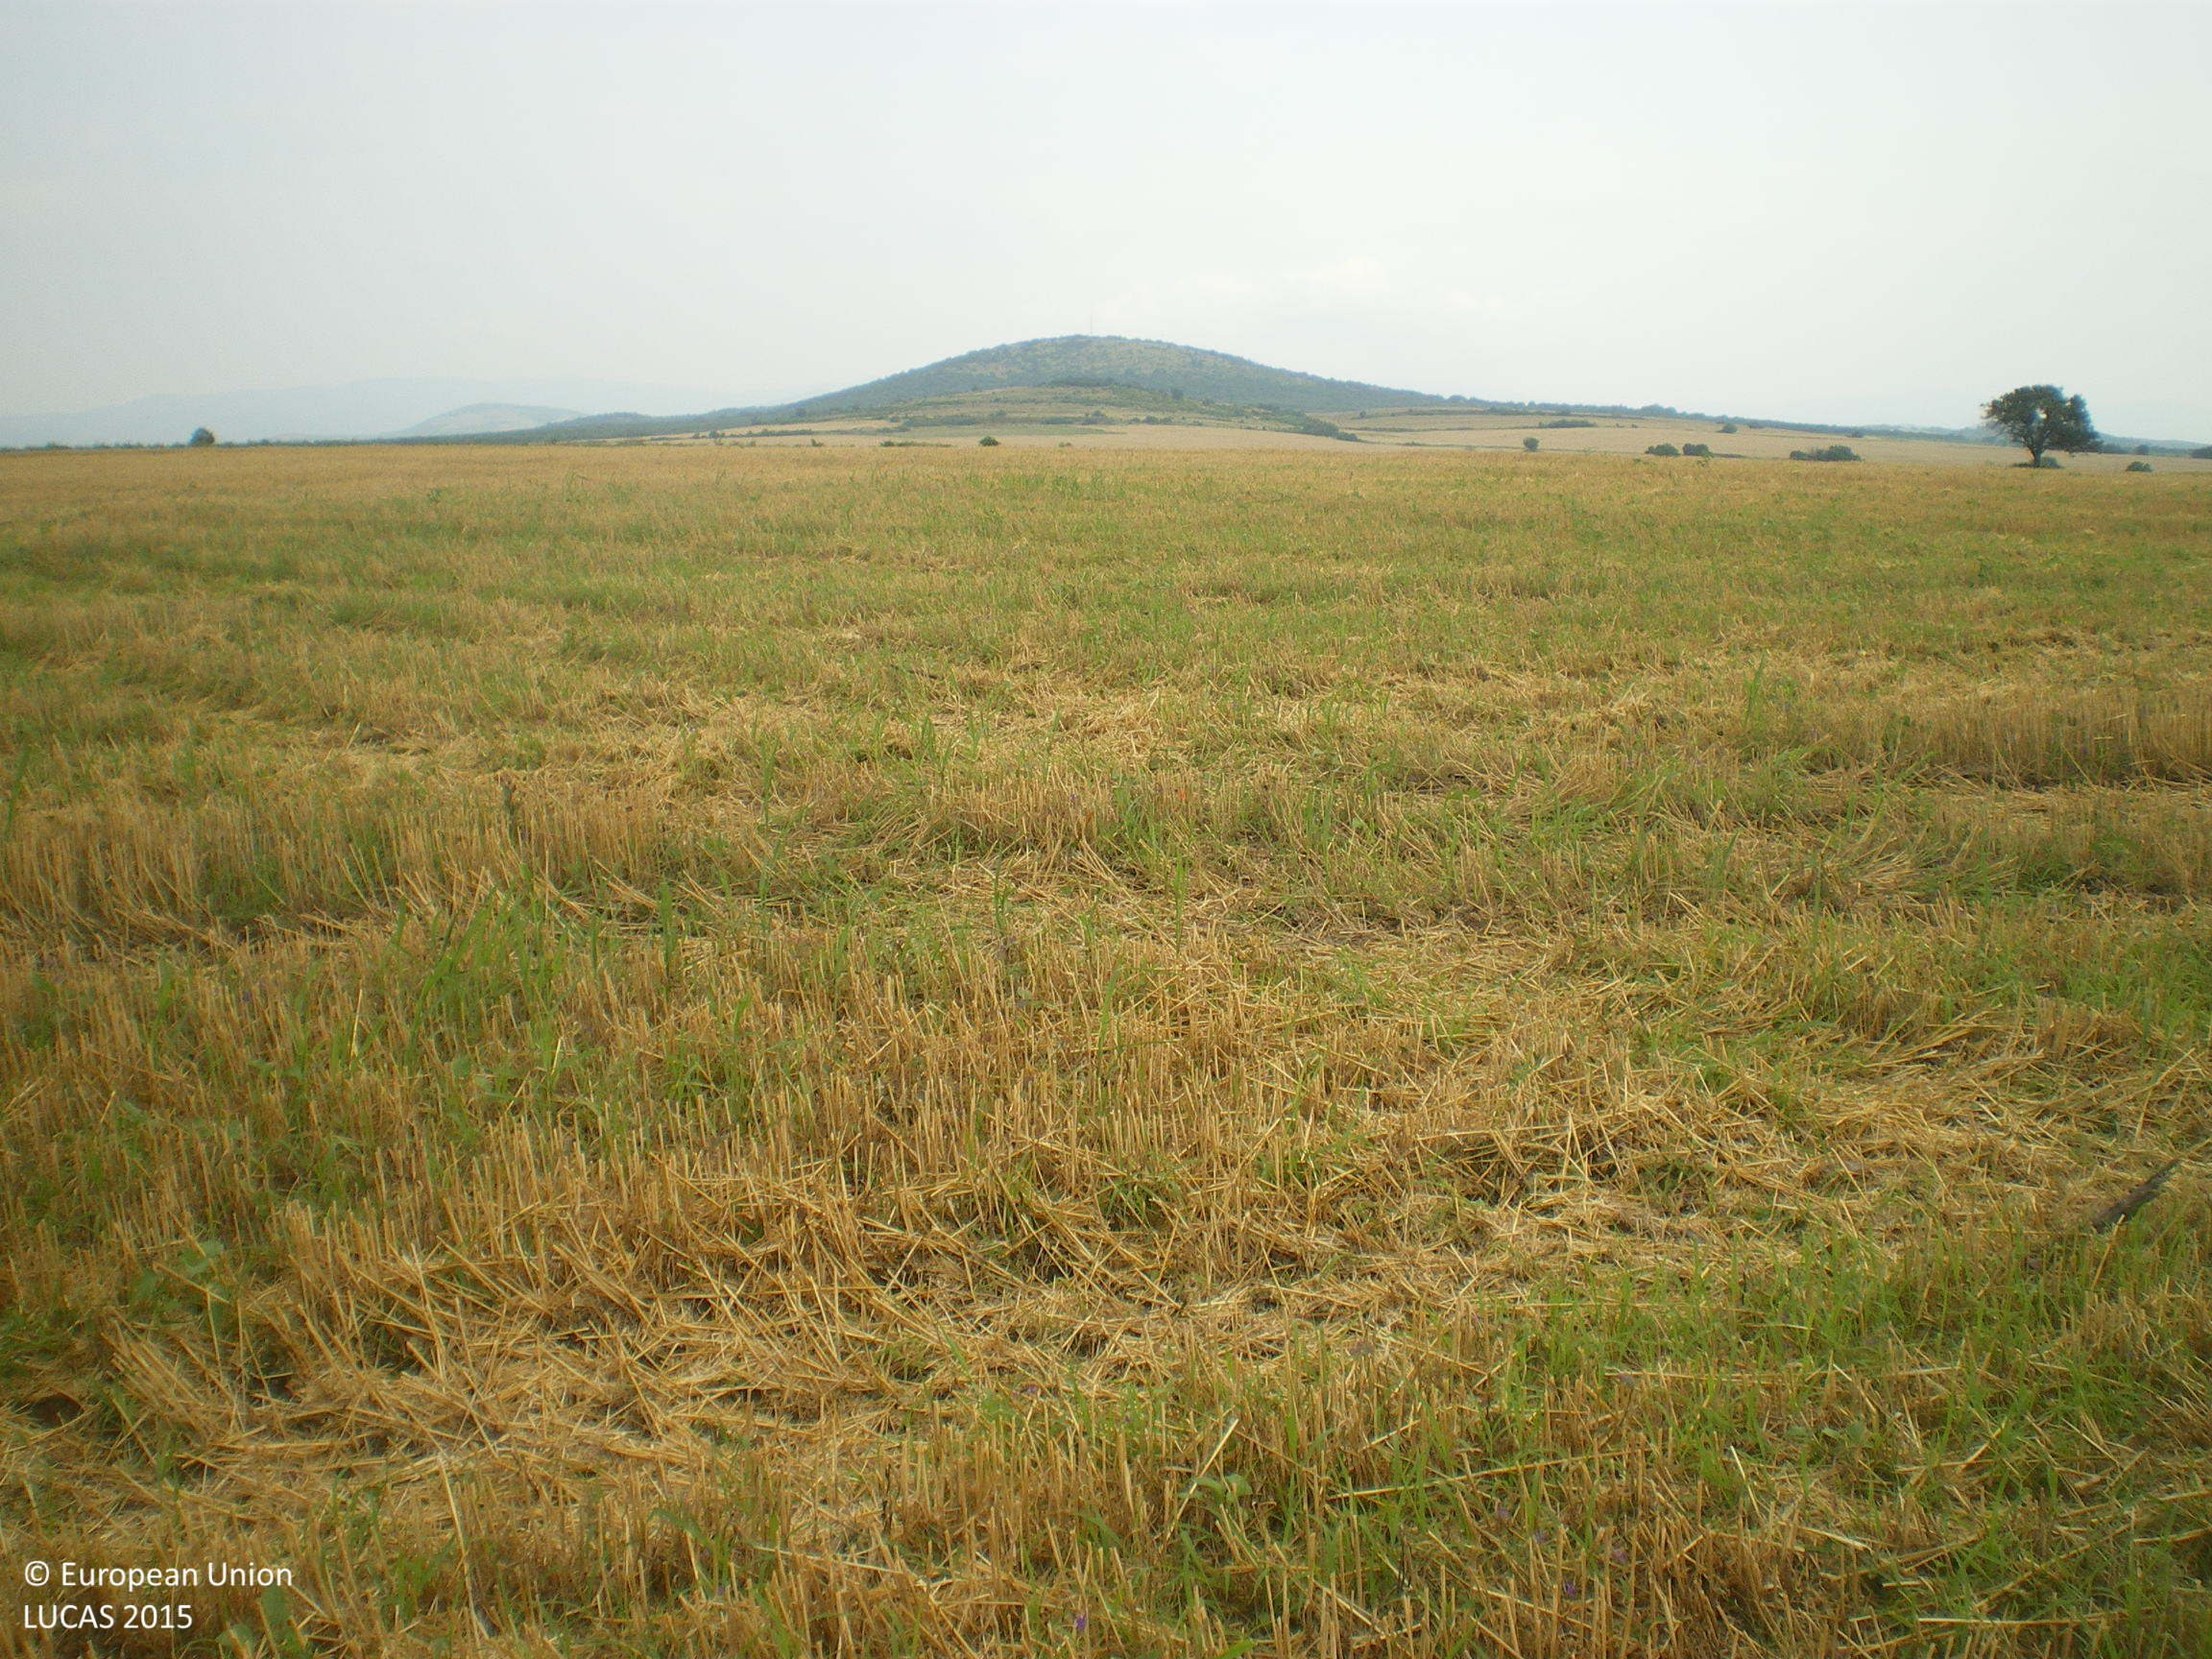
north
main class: Cropland
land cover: Common wheat
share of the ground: 25 - 50 %
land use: Agriculture (excluding fallow land and kitchen gardens)
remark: Harvested field
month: July
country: BG
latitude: 42.3187
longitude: 25.1181
